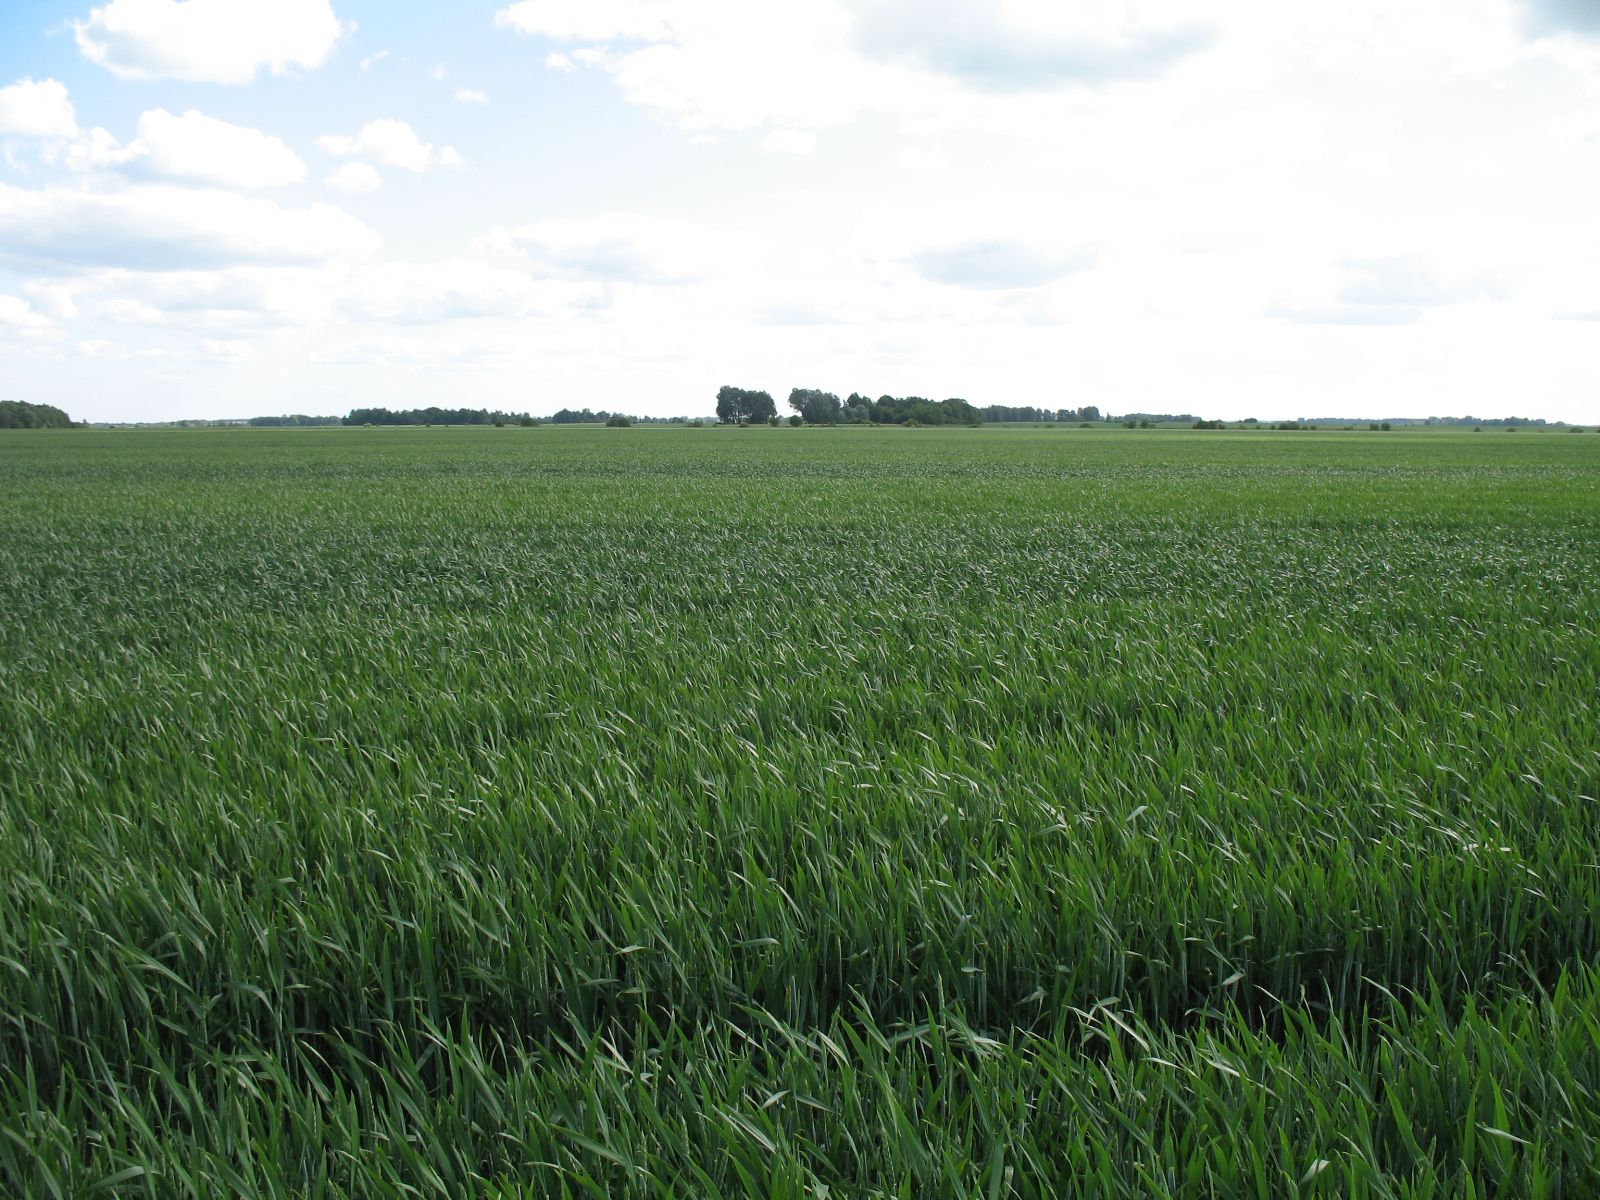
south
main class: Cropland
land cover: Common wheat
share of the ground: > 75 %
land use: Agriculture (excluding fallow land and kitchen gardens)
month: June
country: LV
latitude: 56.4776
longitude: 23.4691
